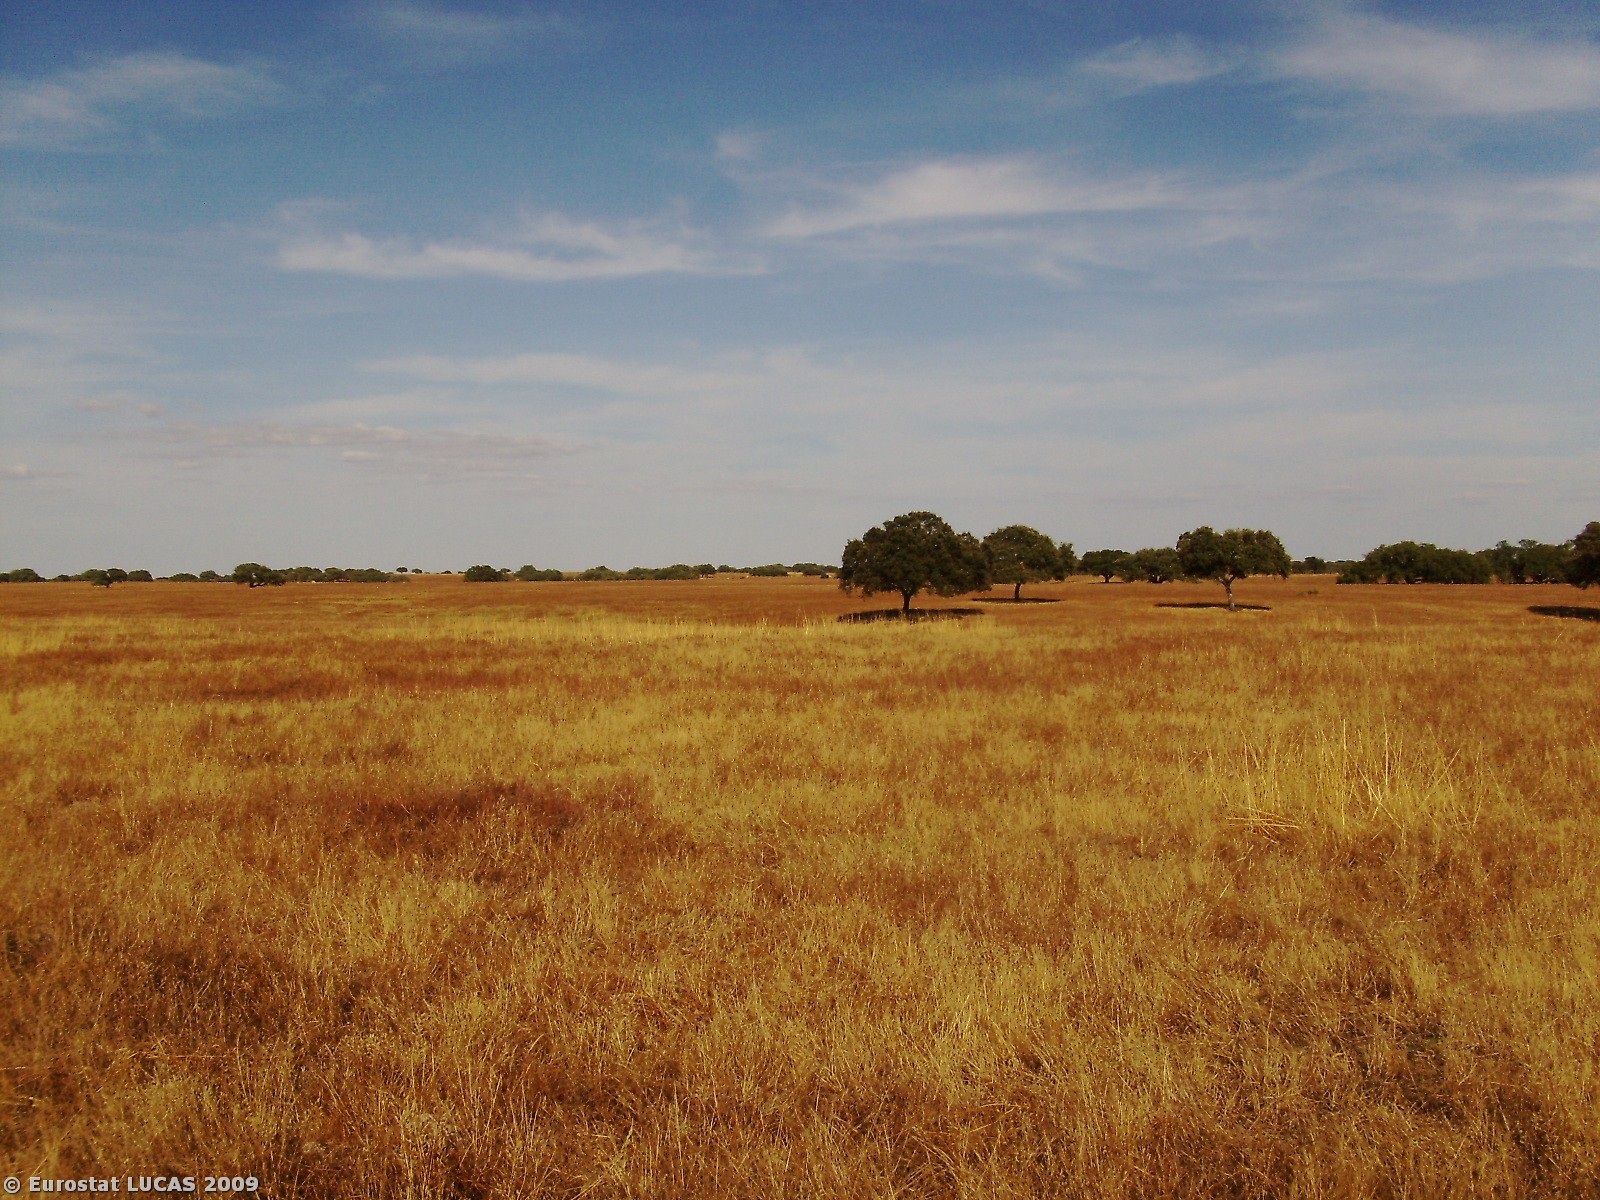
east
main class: Grassland
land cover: Grassland without tree/shrub cover
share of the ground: > 75 %
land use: Agriculture (excluding fallow land and kitchen gardens)
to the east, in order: Grassland without tree/shrub cover; Rivers and streams; Grassland without tree/shrub cover
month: June
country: PT
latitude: 37.9991
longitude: -8.3625
